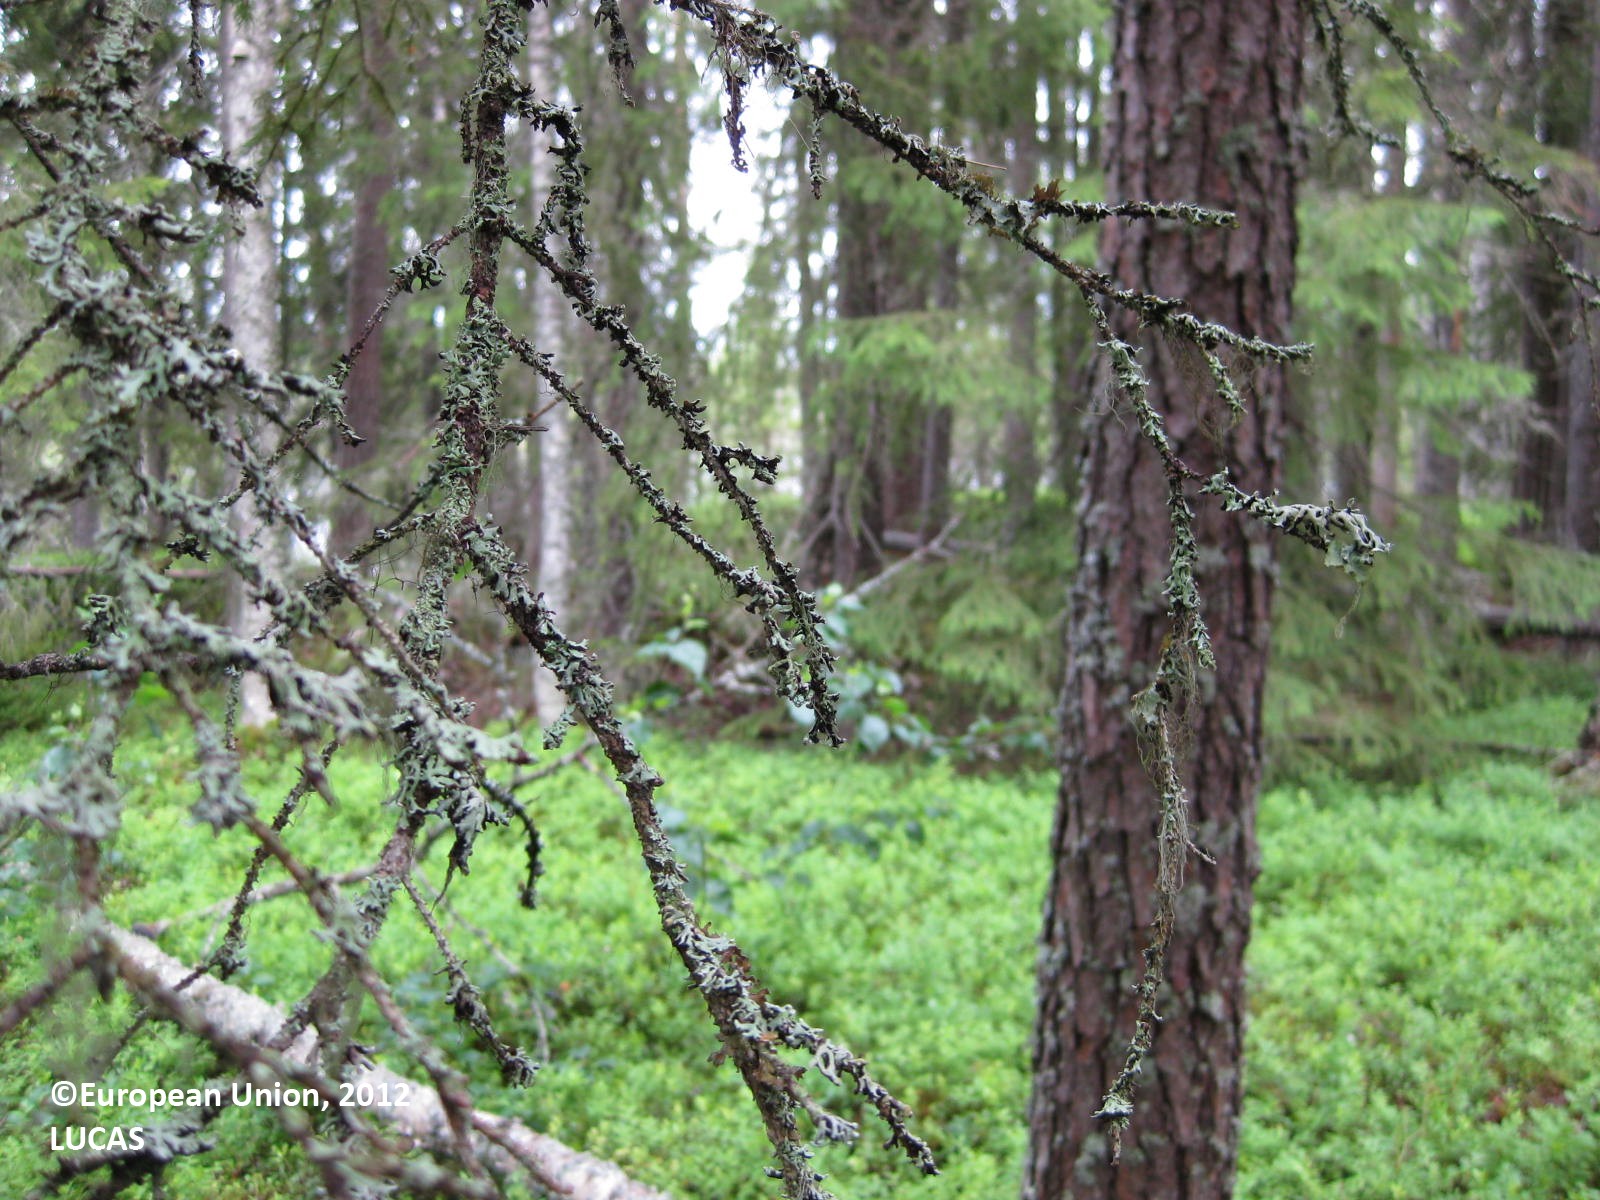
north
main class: Woodland
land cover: Spruce dominated mixed woodland
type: boreal forest
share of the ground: > 75 %
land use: Forestry
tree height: > 5 m
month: July
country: FI
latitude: 65.4657
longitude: 28.3067
